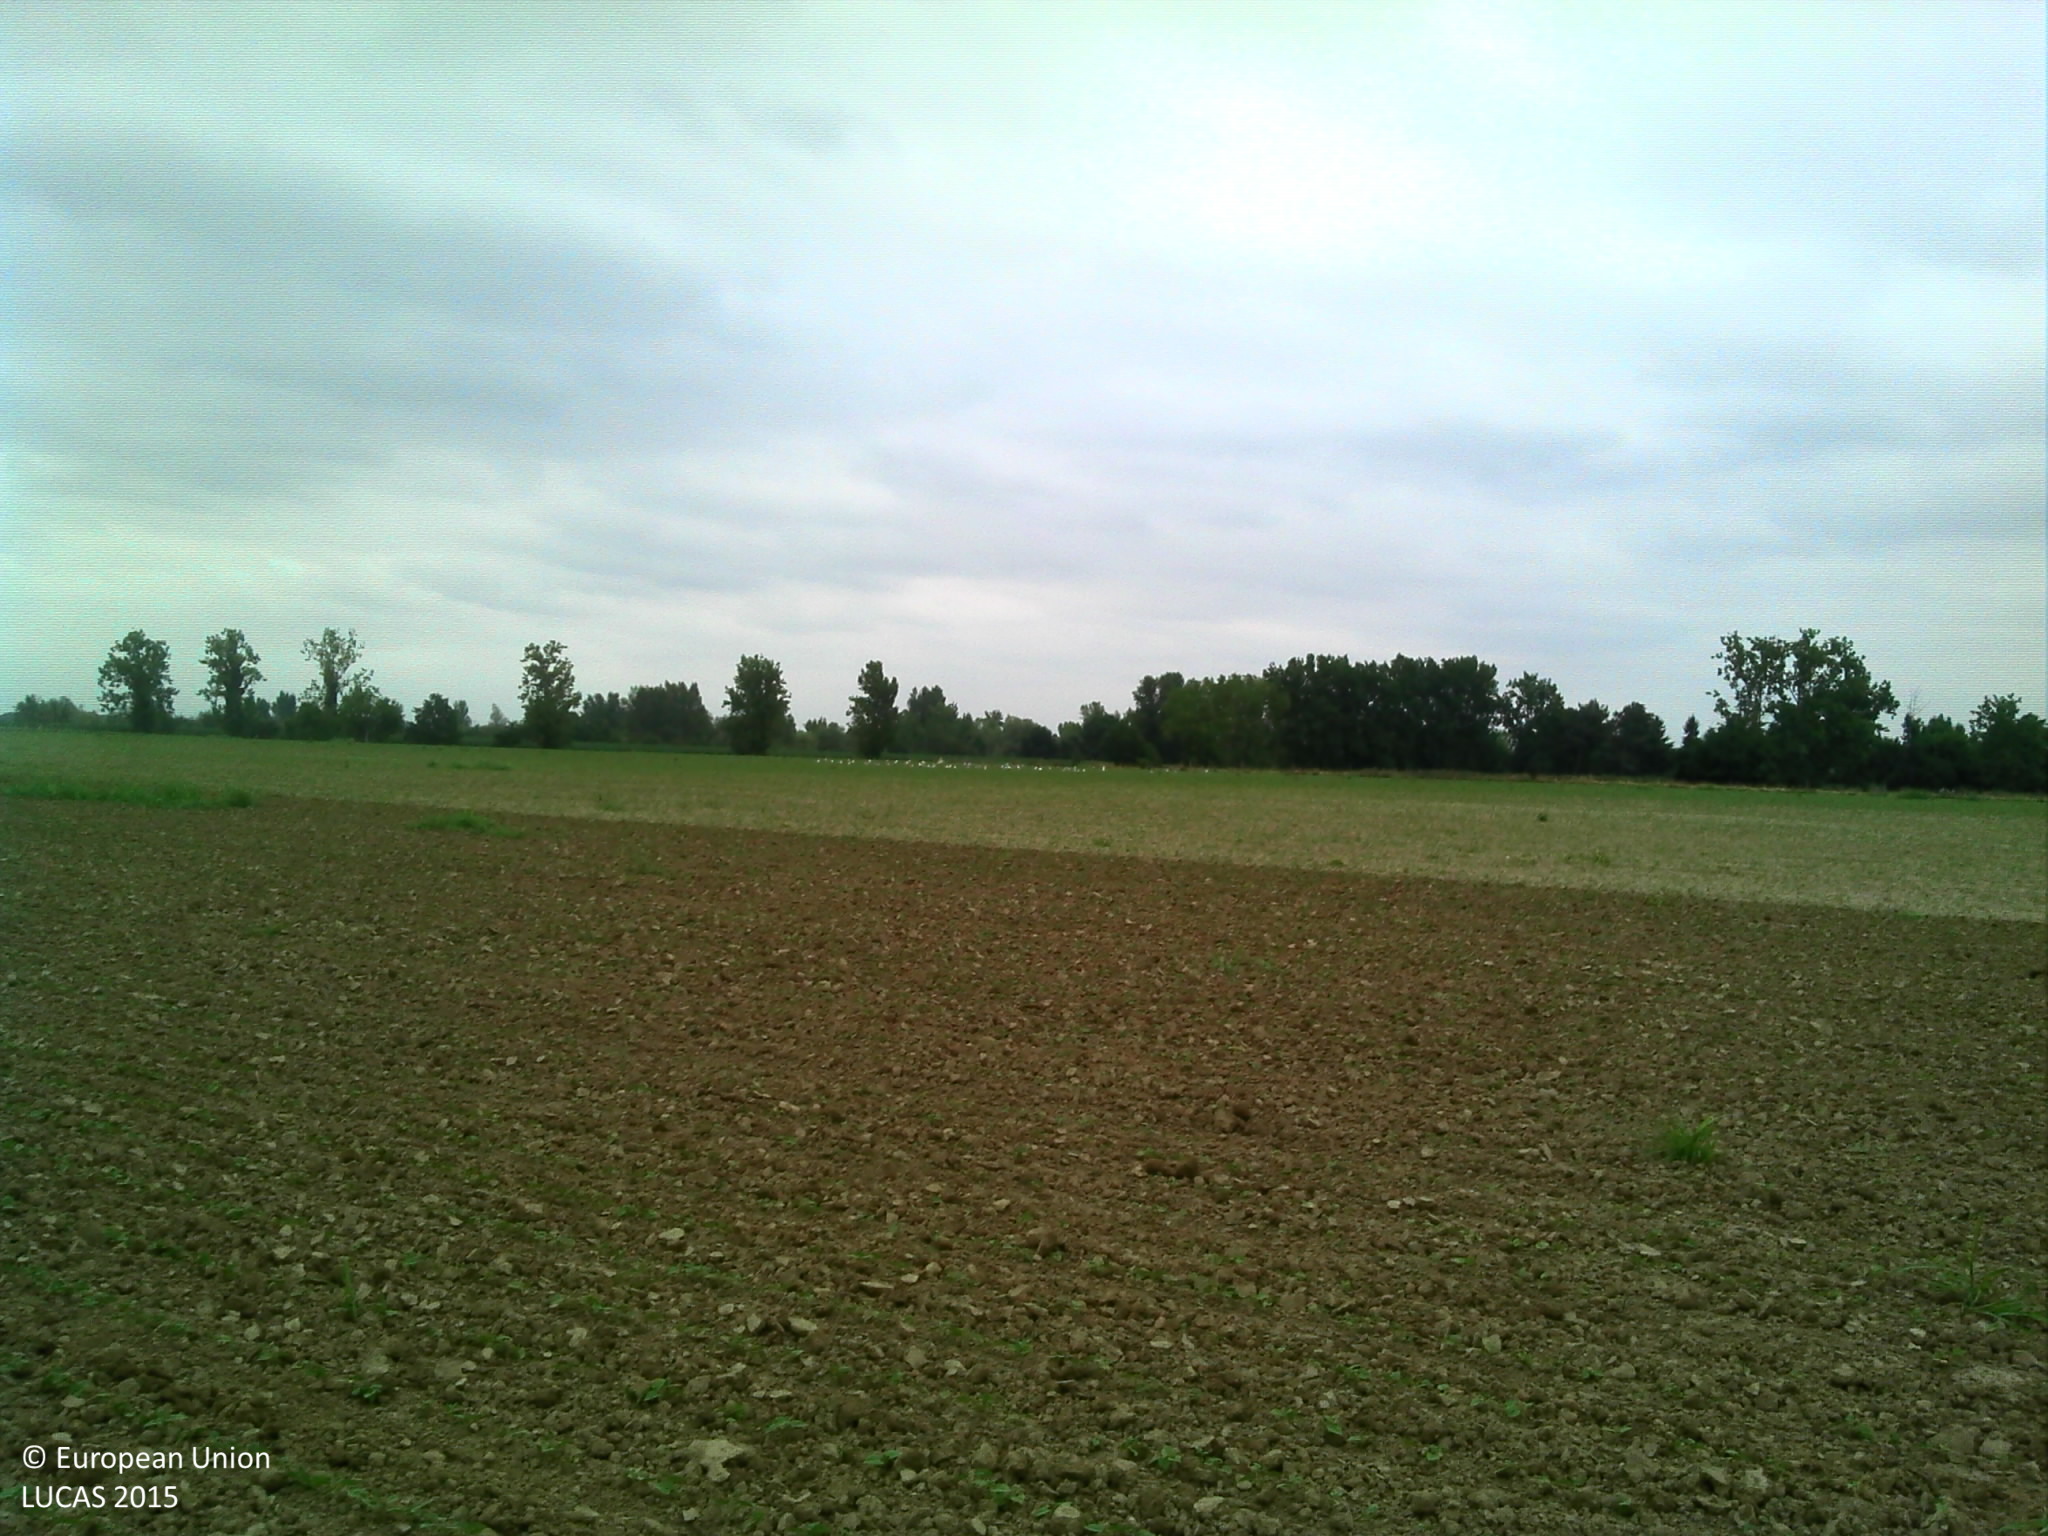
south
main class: Cropland
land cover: Other fresh vegetables
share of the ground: < 10 %
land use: Agriculture (excluding fallow land and kitchen gardens)
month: June
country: FR
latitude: 44.0966
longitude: 0.9160
